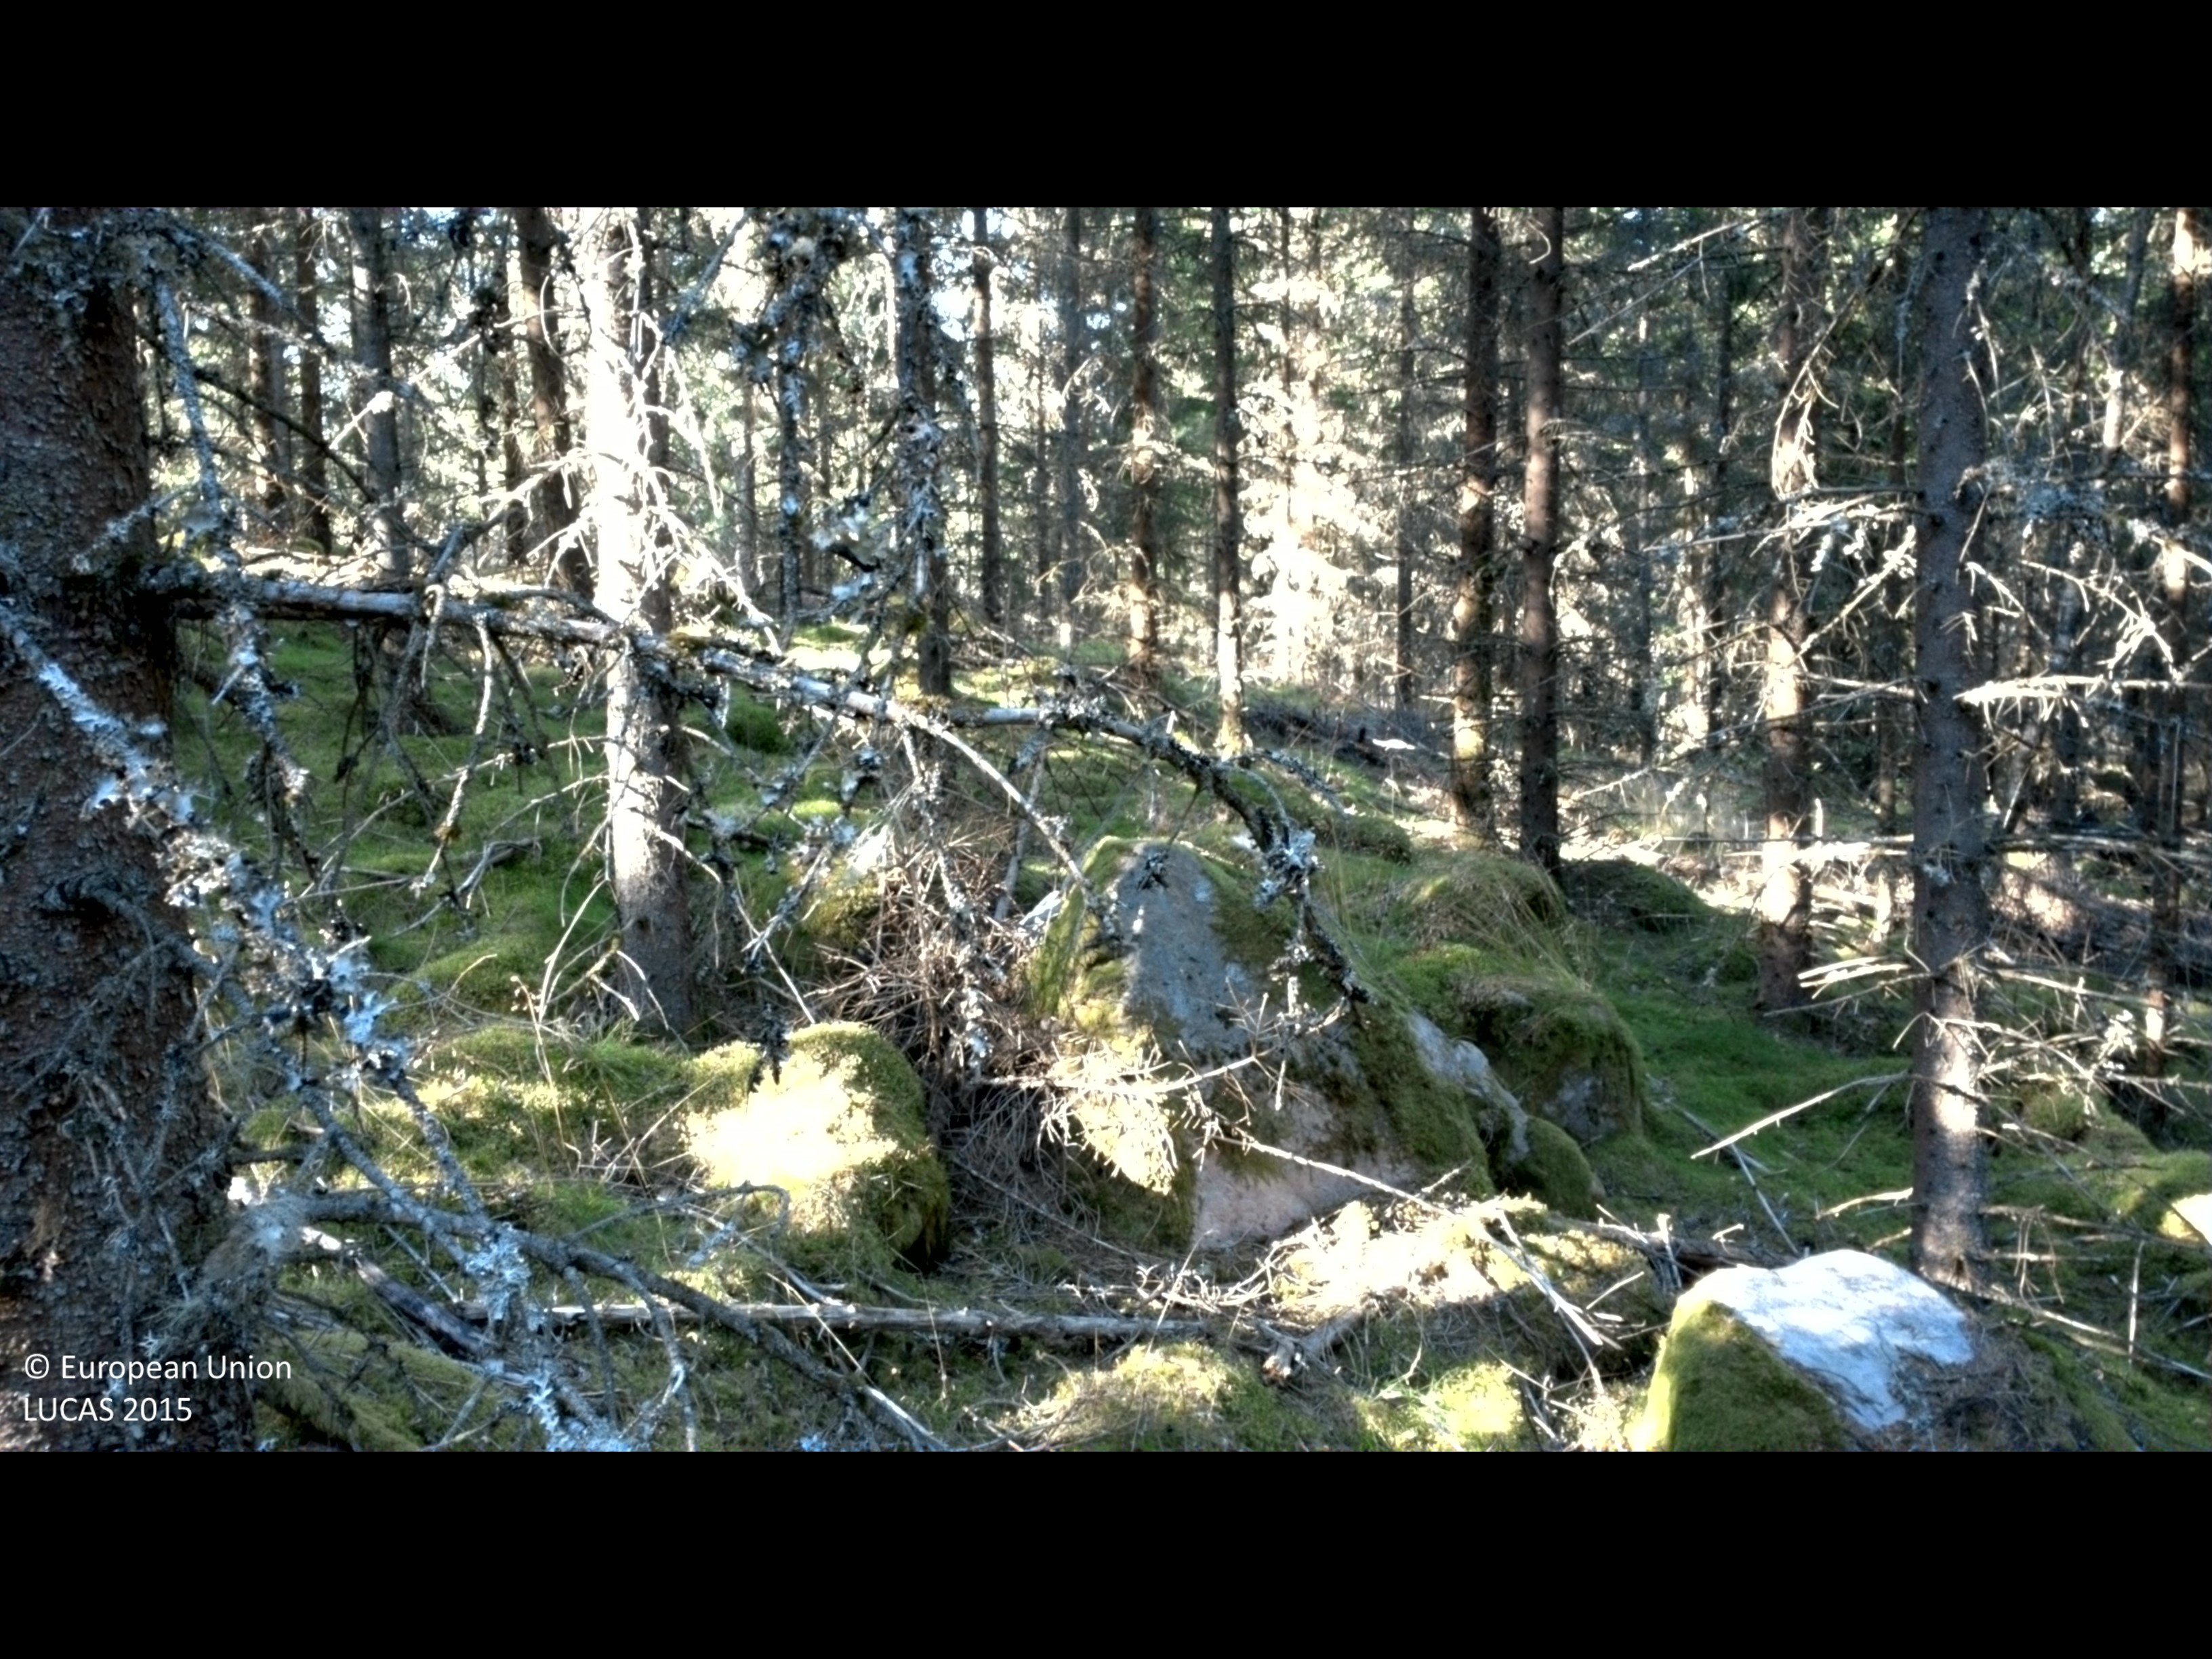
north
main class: Woodland
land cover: Spruce dominated coniferous woodland
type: boreal forest
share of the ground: > 75 %
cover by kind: coniferous forest trees 85 %, lichens and mosses 10 %, herbaceous plants 5 %
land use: Forestry
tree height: > 5 m
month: August
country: SE
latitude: 56.8200
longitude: 14.2401
